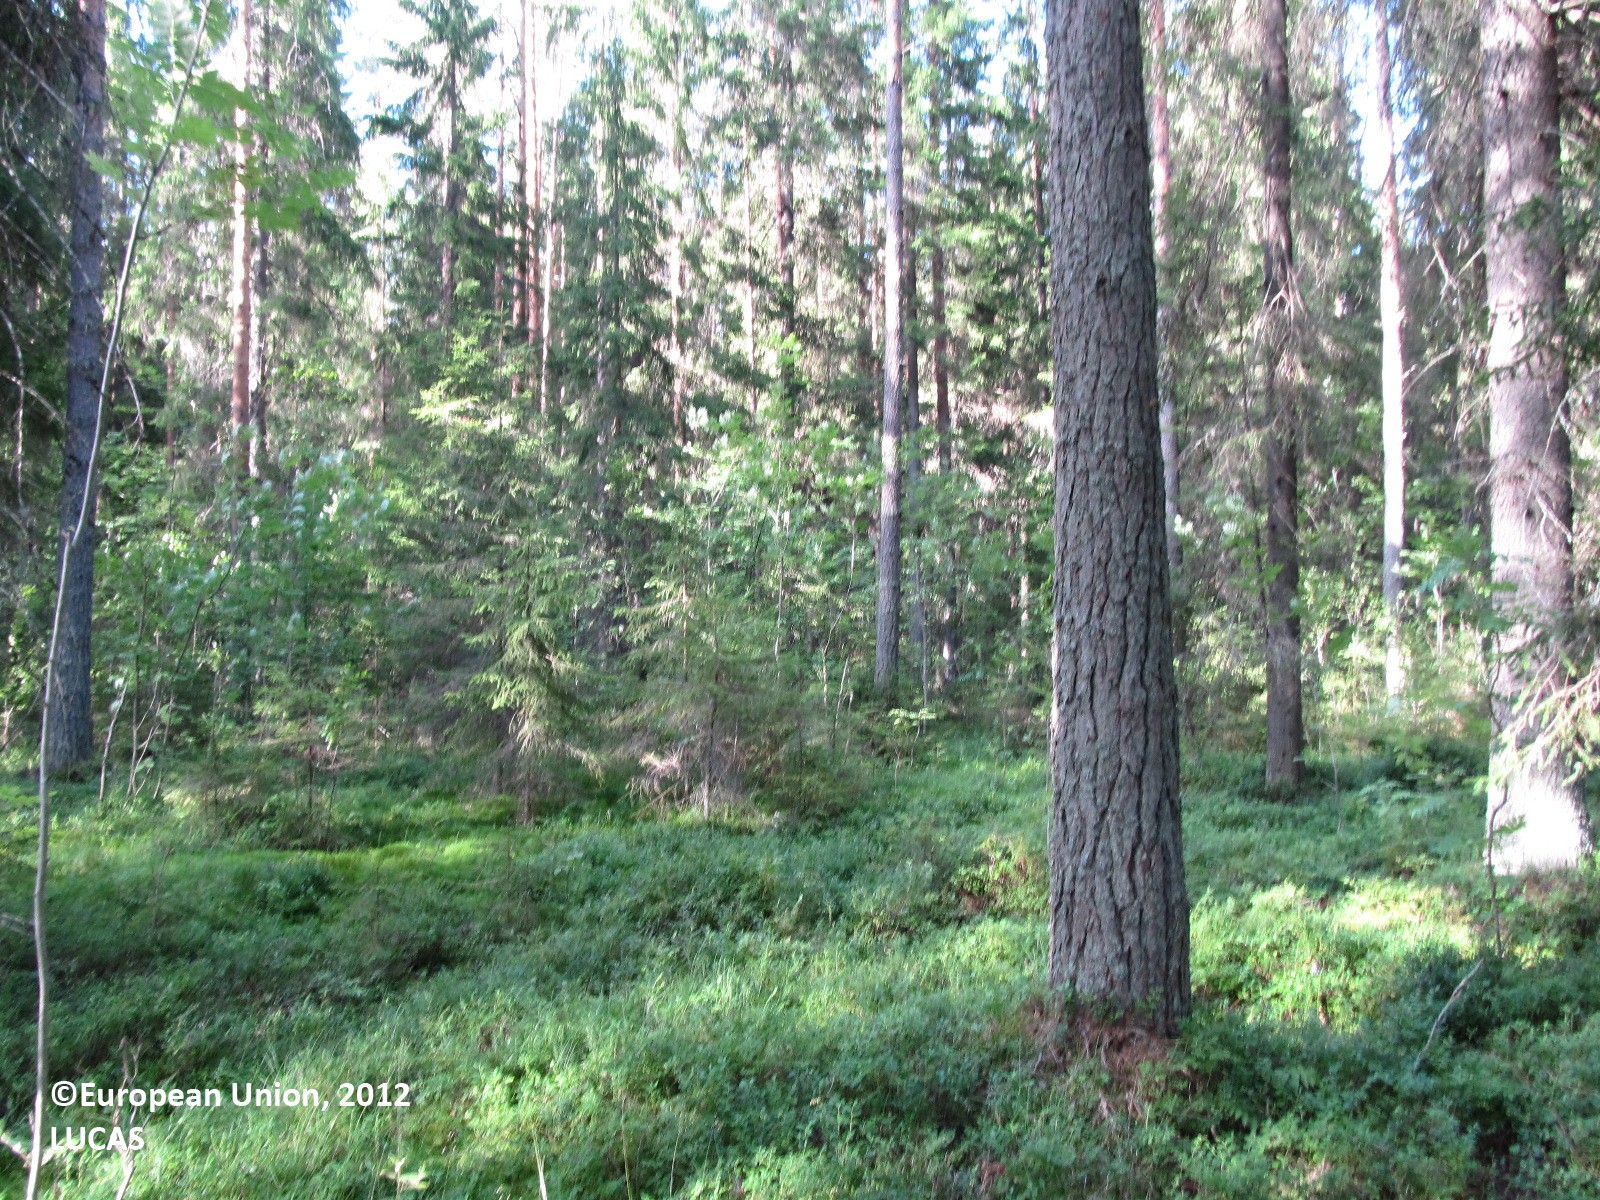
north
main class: Woodland
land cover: Spruce dominated coniferous woodland
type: boreal forest
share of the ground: 25 - 50 %
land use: Forestry
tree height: > 5 m
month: August
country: FI
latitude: 61.8661
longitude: 27.8460
